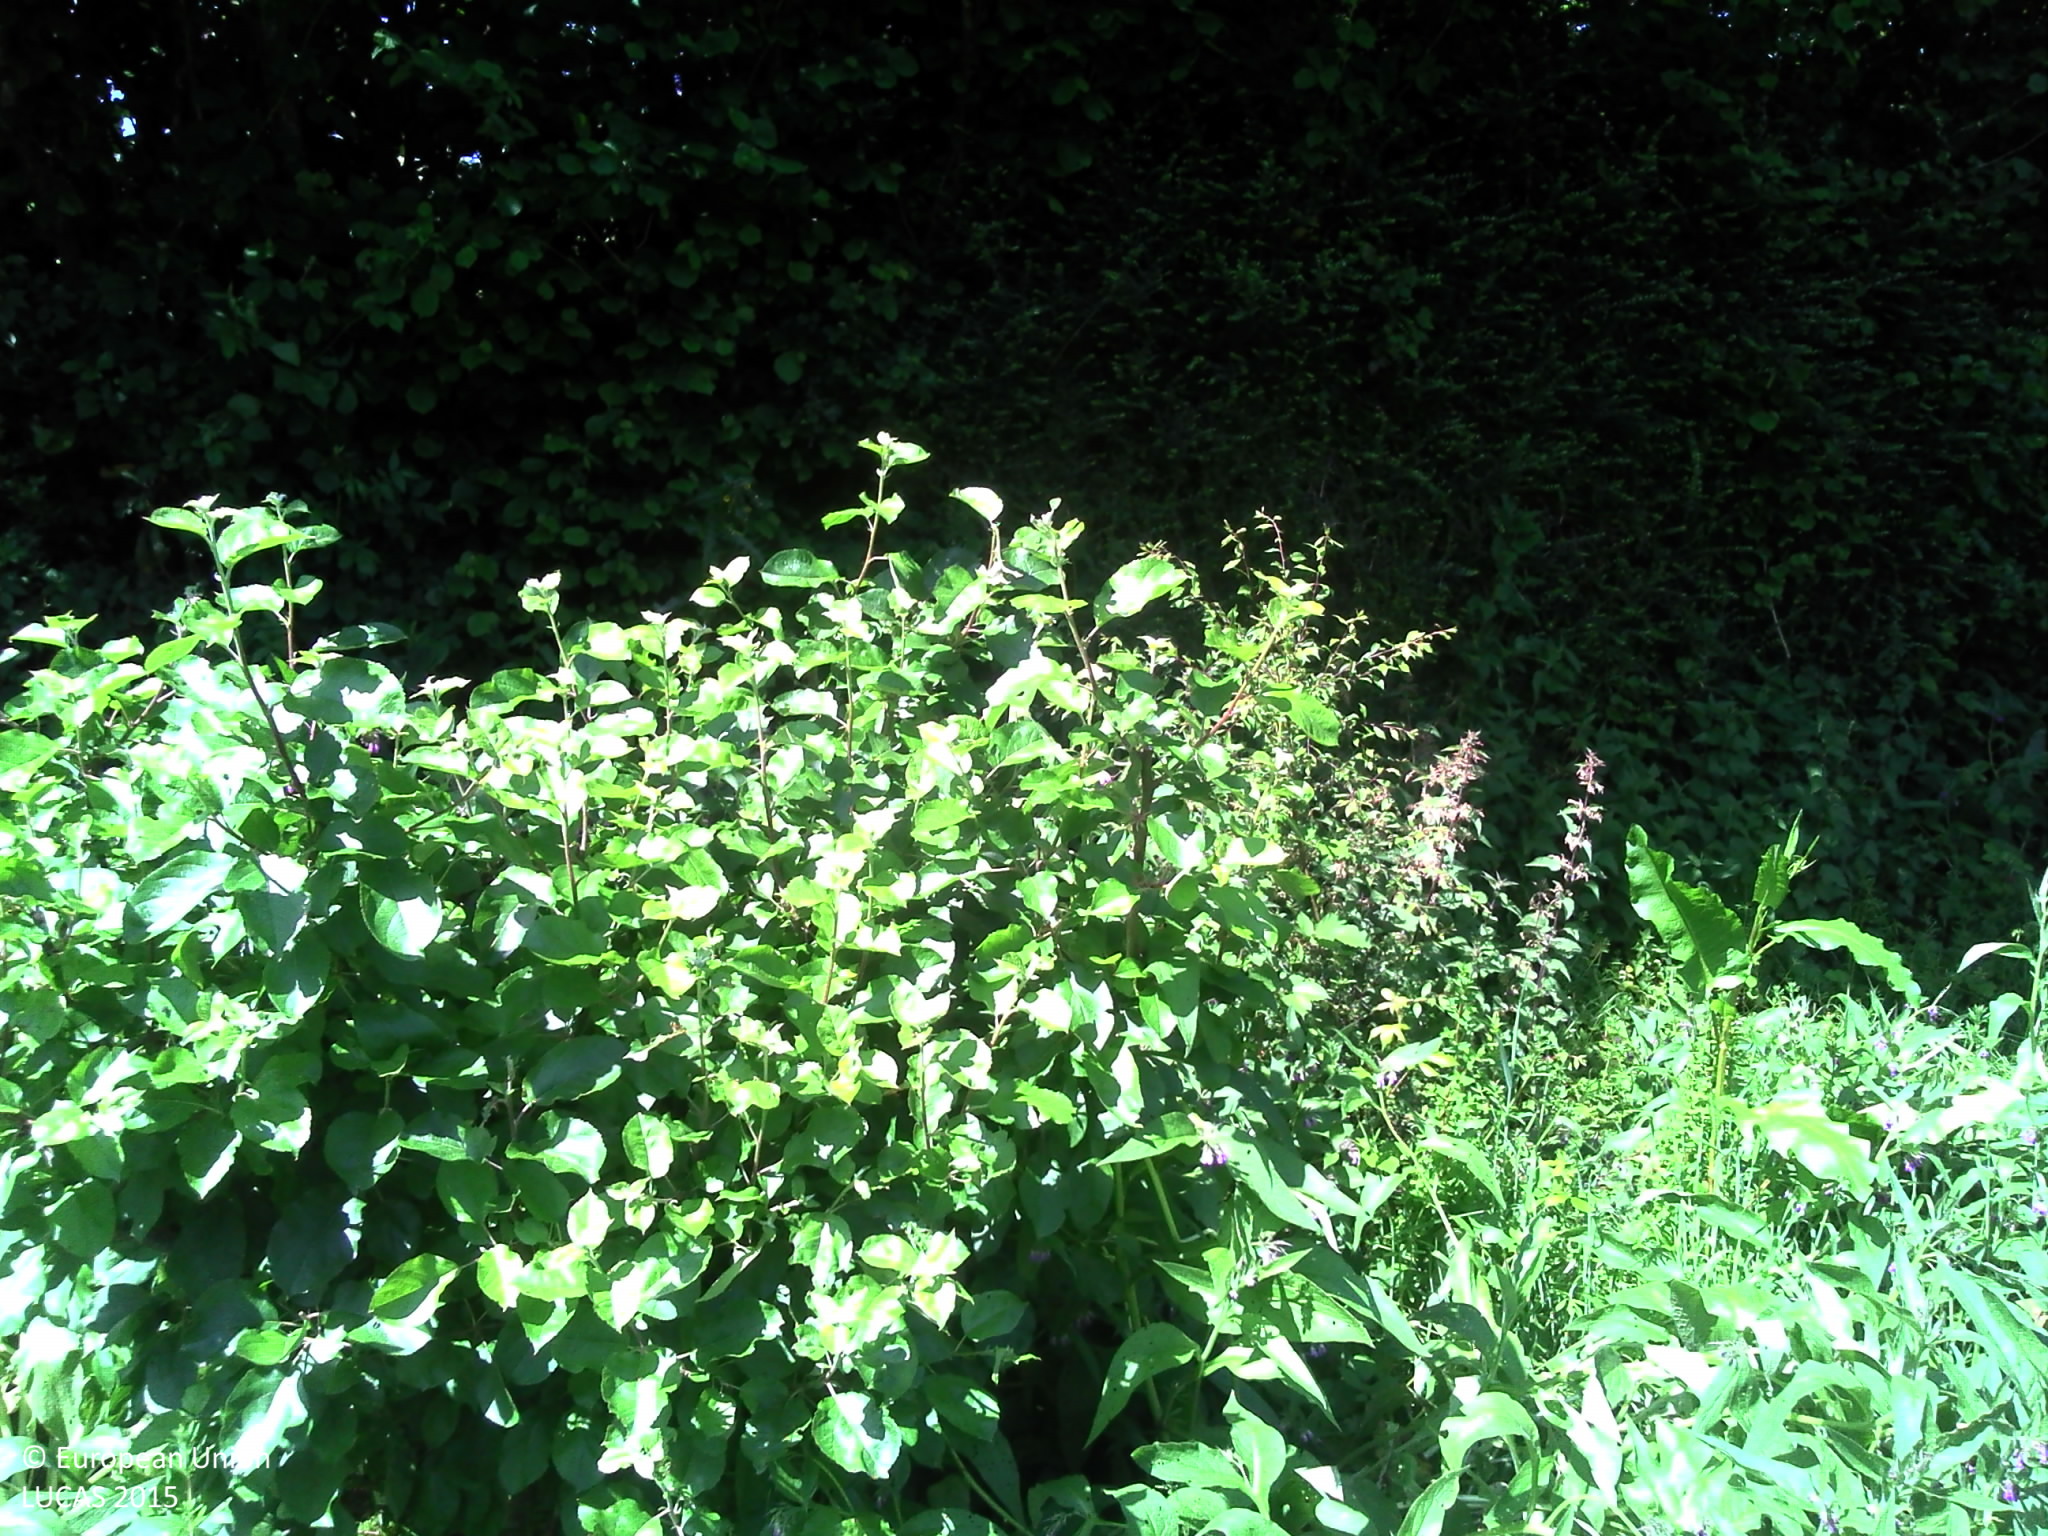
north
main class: Grassland
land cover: Spontaneously vegetated surfaces
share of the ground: > 75 %
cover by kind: herbaceous plants 100 %
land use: Residential
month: June
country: FR
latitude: 49.4896
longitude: -1.6897
